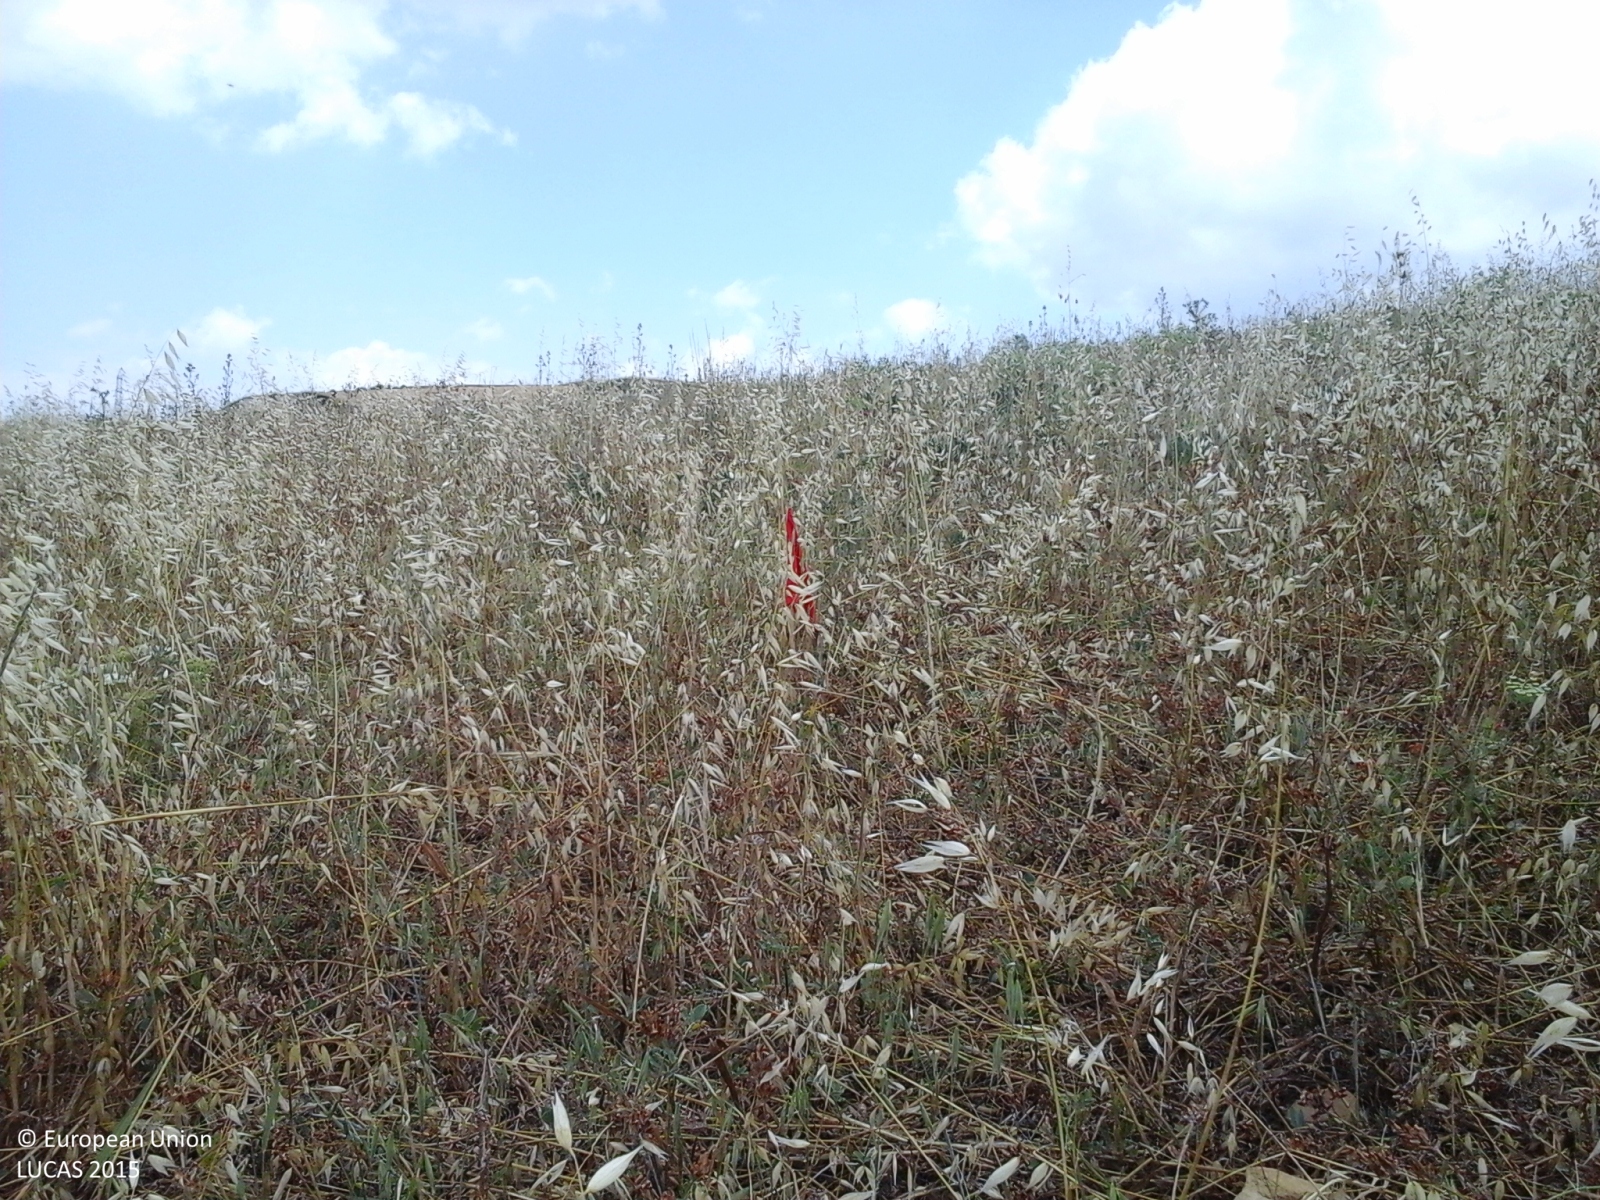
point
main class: Grassland
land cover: Spontaneously vegetated surfaces
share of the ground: > 75 %
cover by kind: herbaceous plants 100 %
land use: Fallow land
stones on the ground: < 10 %
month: June
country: IT
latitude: 37.9007
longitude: 13.5117
